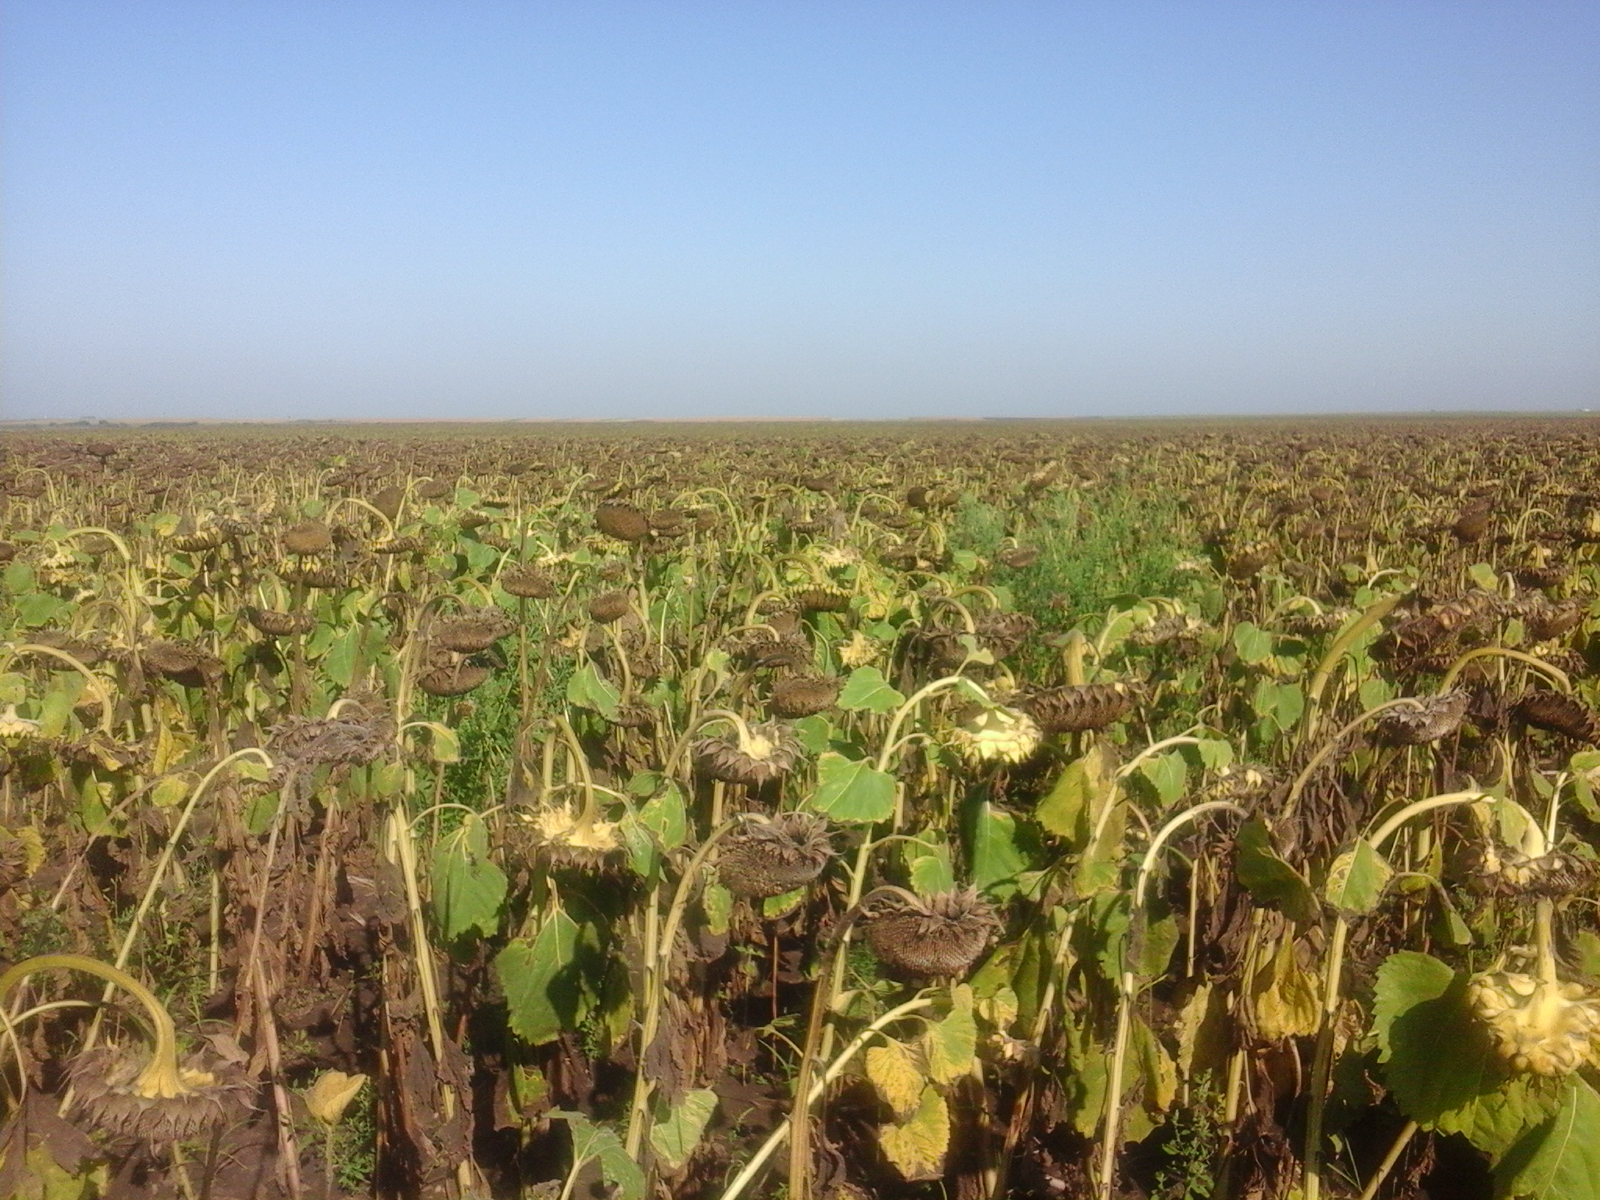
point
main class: Cropland
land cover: Sunflower
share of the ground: > 75 %
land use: Agriculture (excluding fallow land and kitchen gardens)
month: August
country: RO
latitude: 45.8657
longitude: 21.0687
